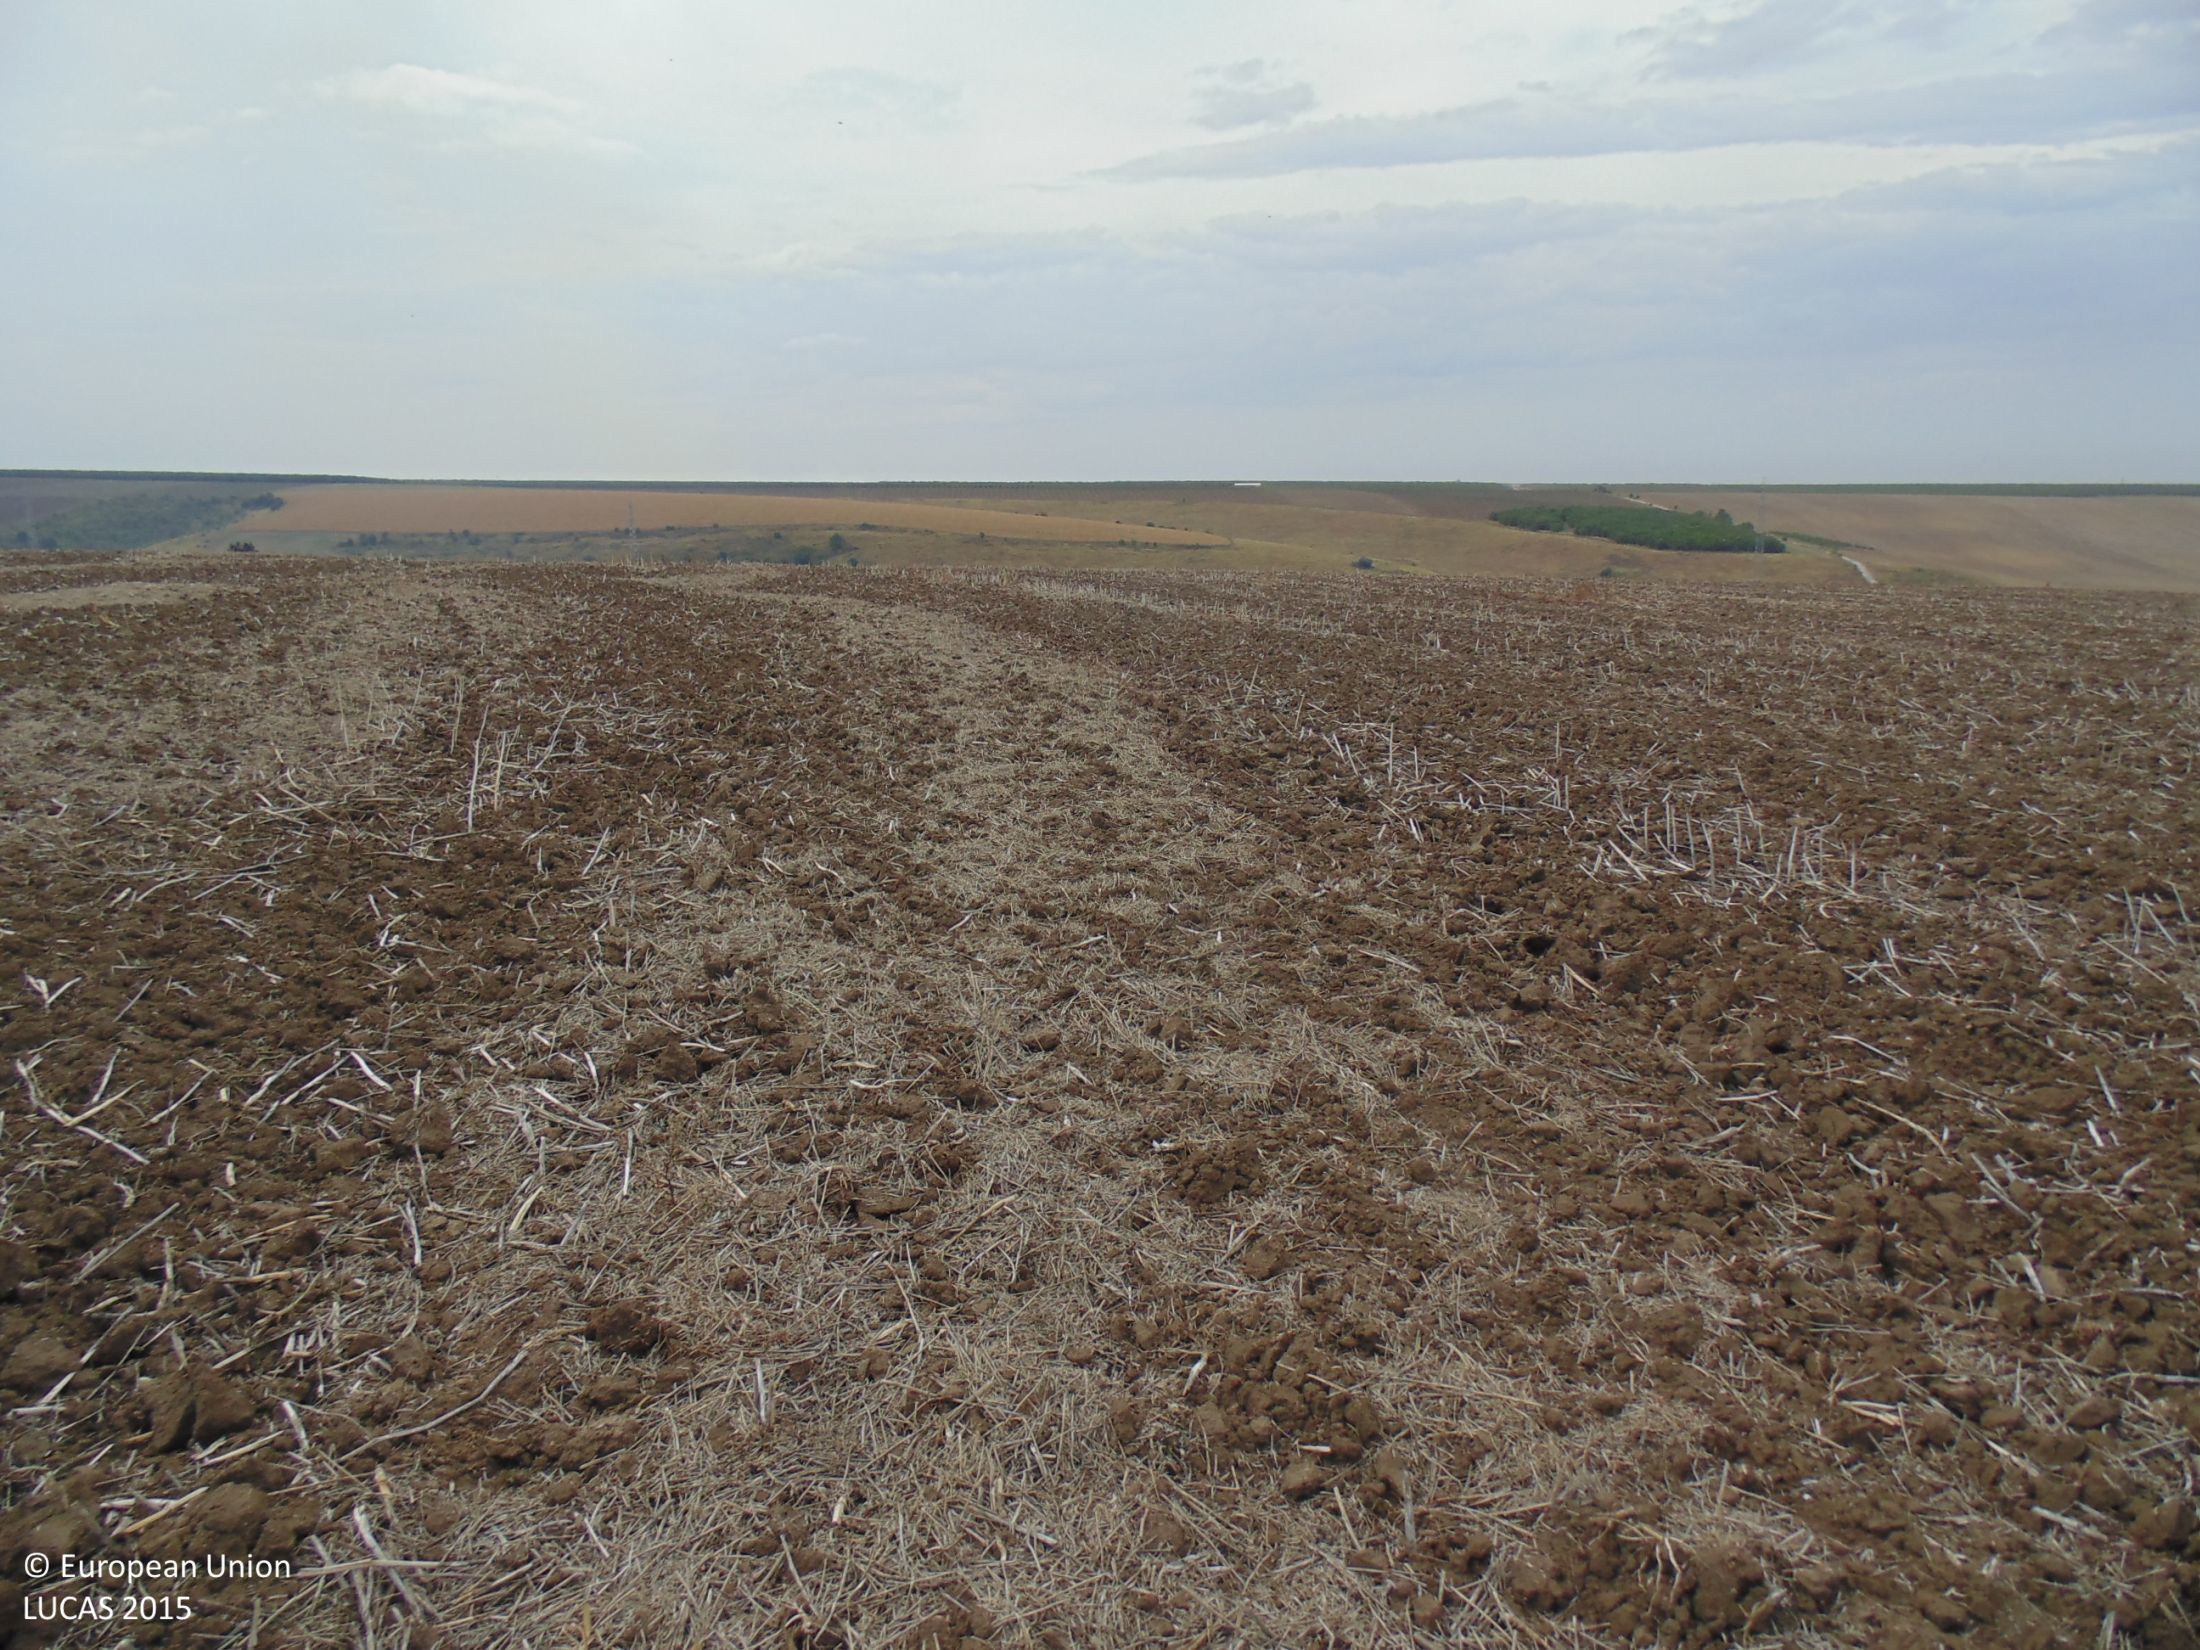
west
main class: Cropland
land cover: Rape and turnip rape
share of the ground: < 10 %
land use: Agriculture (excluding fallow land and kitchen gardens)
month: September
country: BG
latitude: 43.9877
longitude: 27.1976
